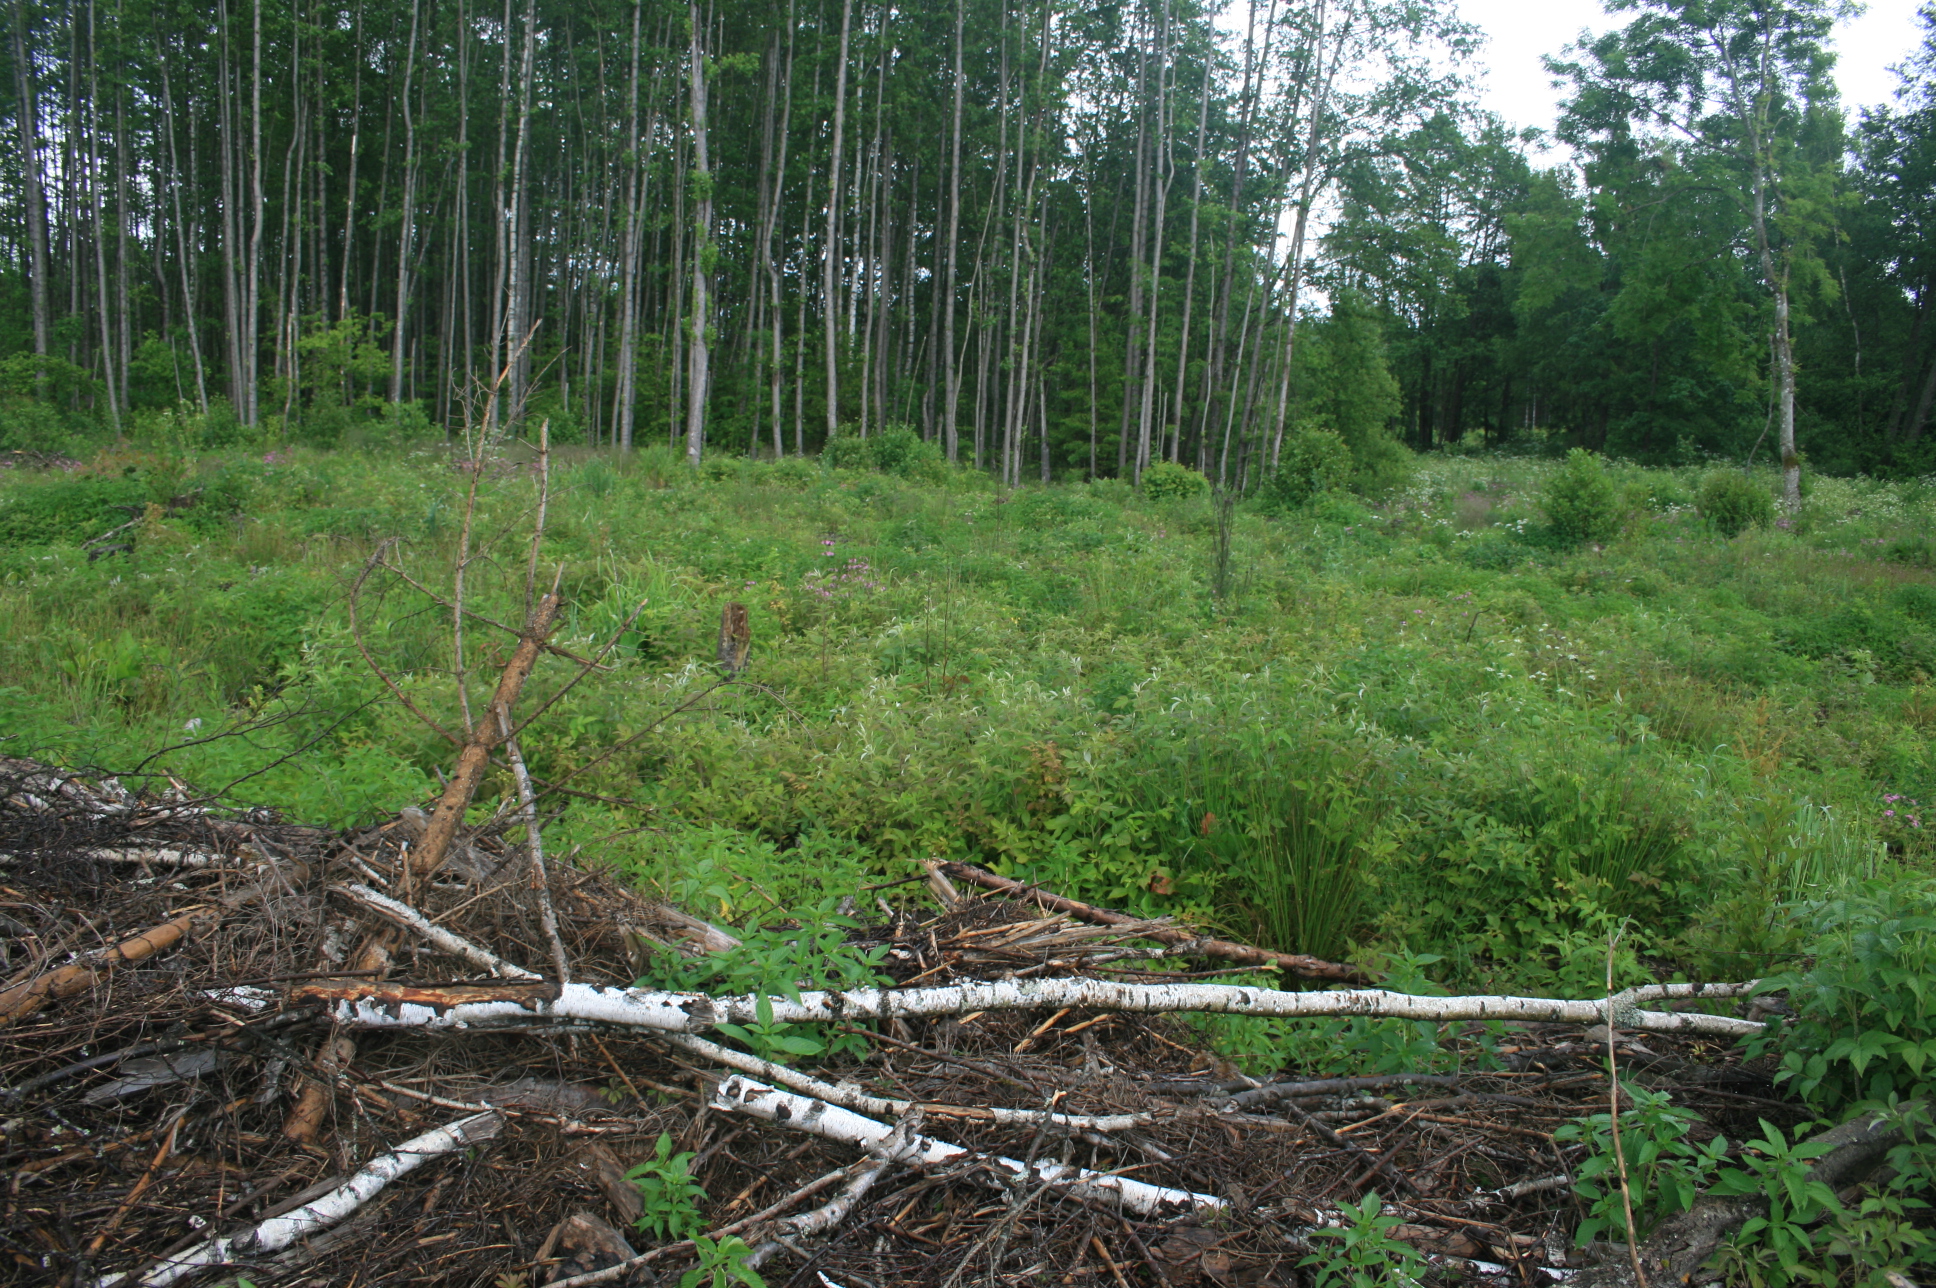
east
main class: Shrubland
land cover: Shrubland with sparse tree cover
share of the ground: > 75 %
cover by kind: shrubs 65 %, herbaceous plants 30 %, broadleaved forest trees 5 %
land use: Forestry
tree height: < 5 m
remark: Clear cut
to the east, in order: Shrubland with sparse tree cover; Broadleaved woodland; Shrubland without tree cover; Spontaneously vegetated surfaces; Common wheat; Spontaneously vegetated surfaces; Ditches and canals; Spontaneously vegetated surfaces; Common wheat; Spruce dominated mixed woodland; Spruce dominated coniferous woodland
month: June
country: LT
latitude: 55.3440
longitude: 22.0541
